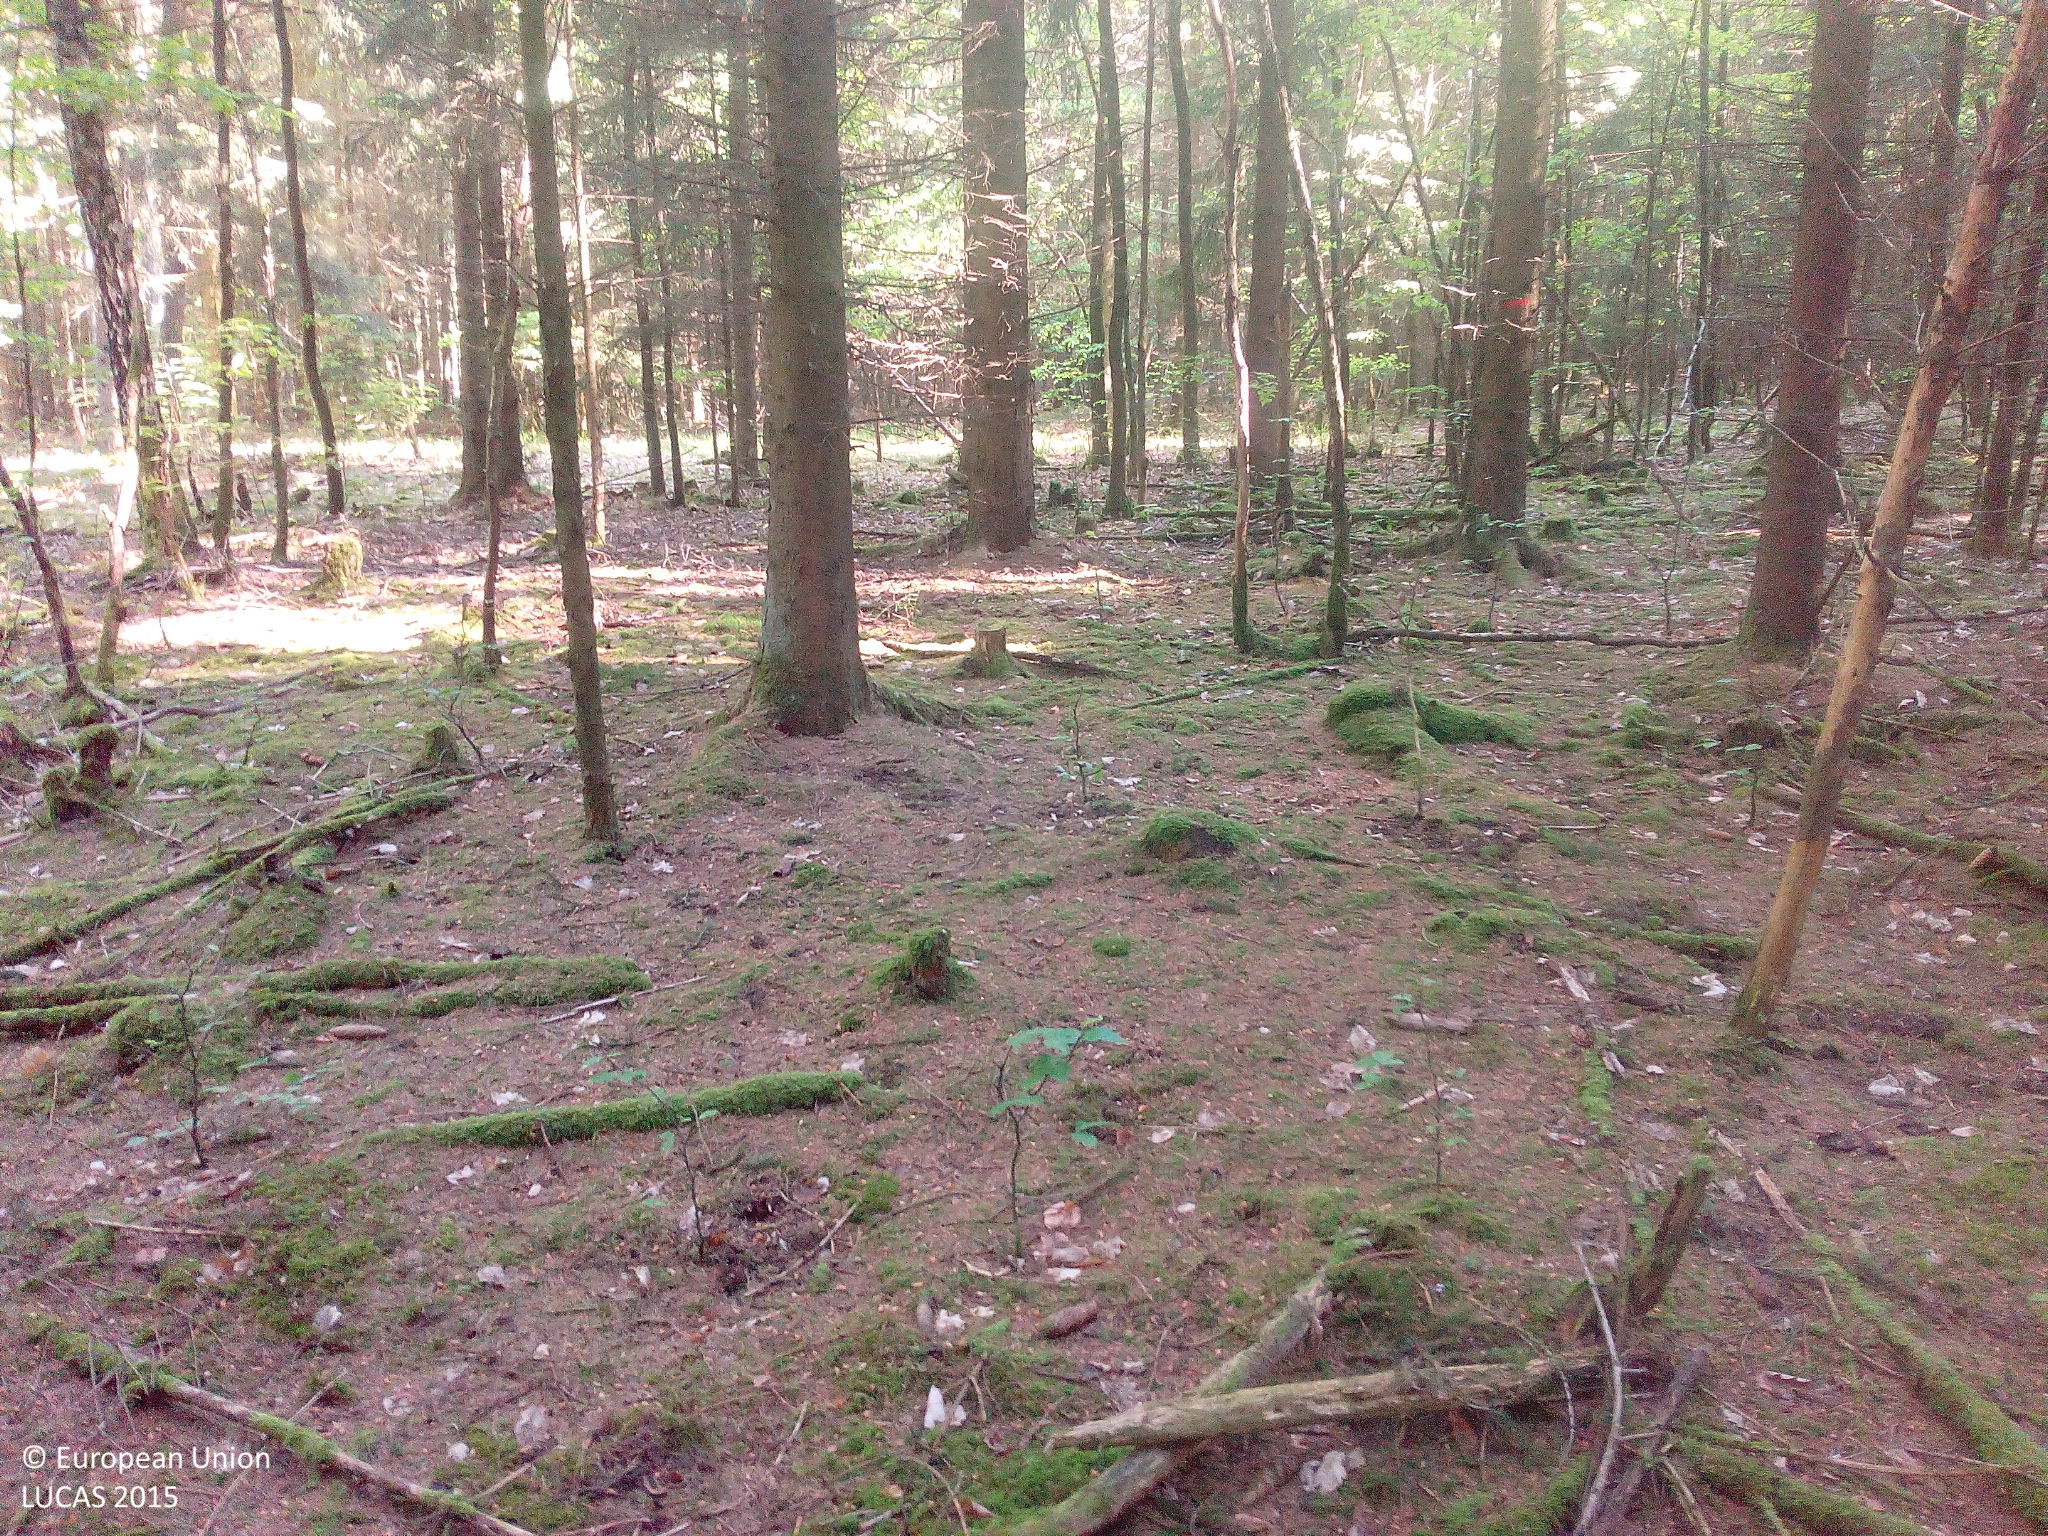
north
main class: Woodland
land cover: Spruce dominated coniferous woodland
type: hemiboreal forest and nemoral coniferous forest and mixed broadleaved-coniferous forest
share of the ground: > 75 %
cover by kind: coniferous forest trees 100 %
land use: Forestry
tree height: > 5 m
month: May
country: DE
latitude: 49.9826
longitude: 10.9341
